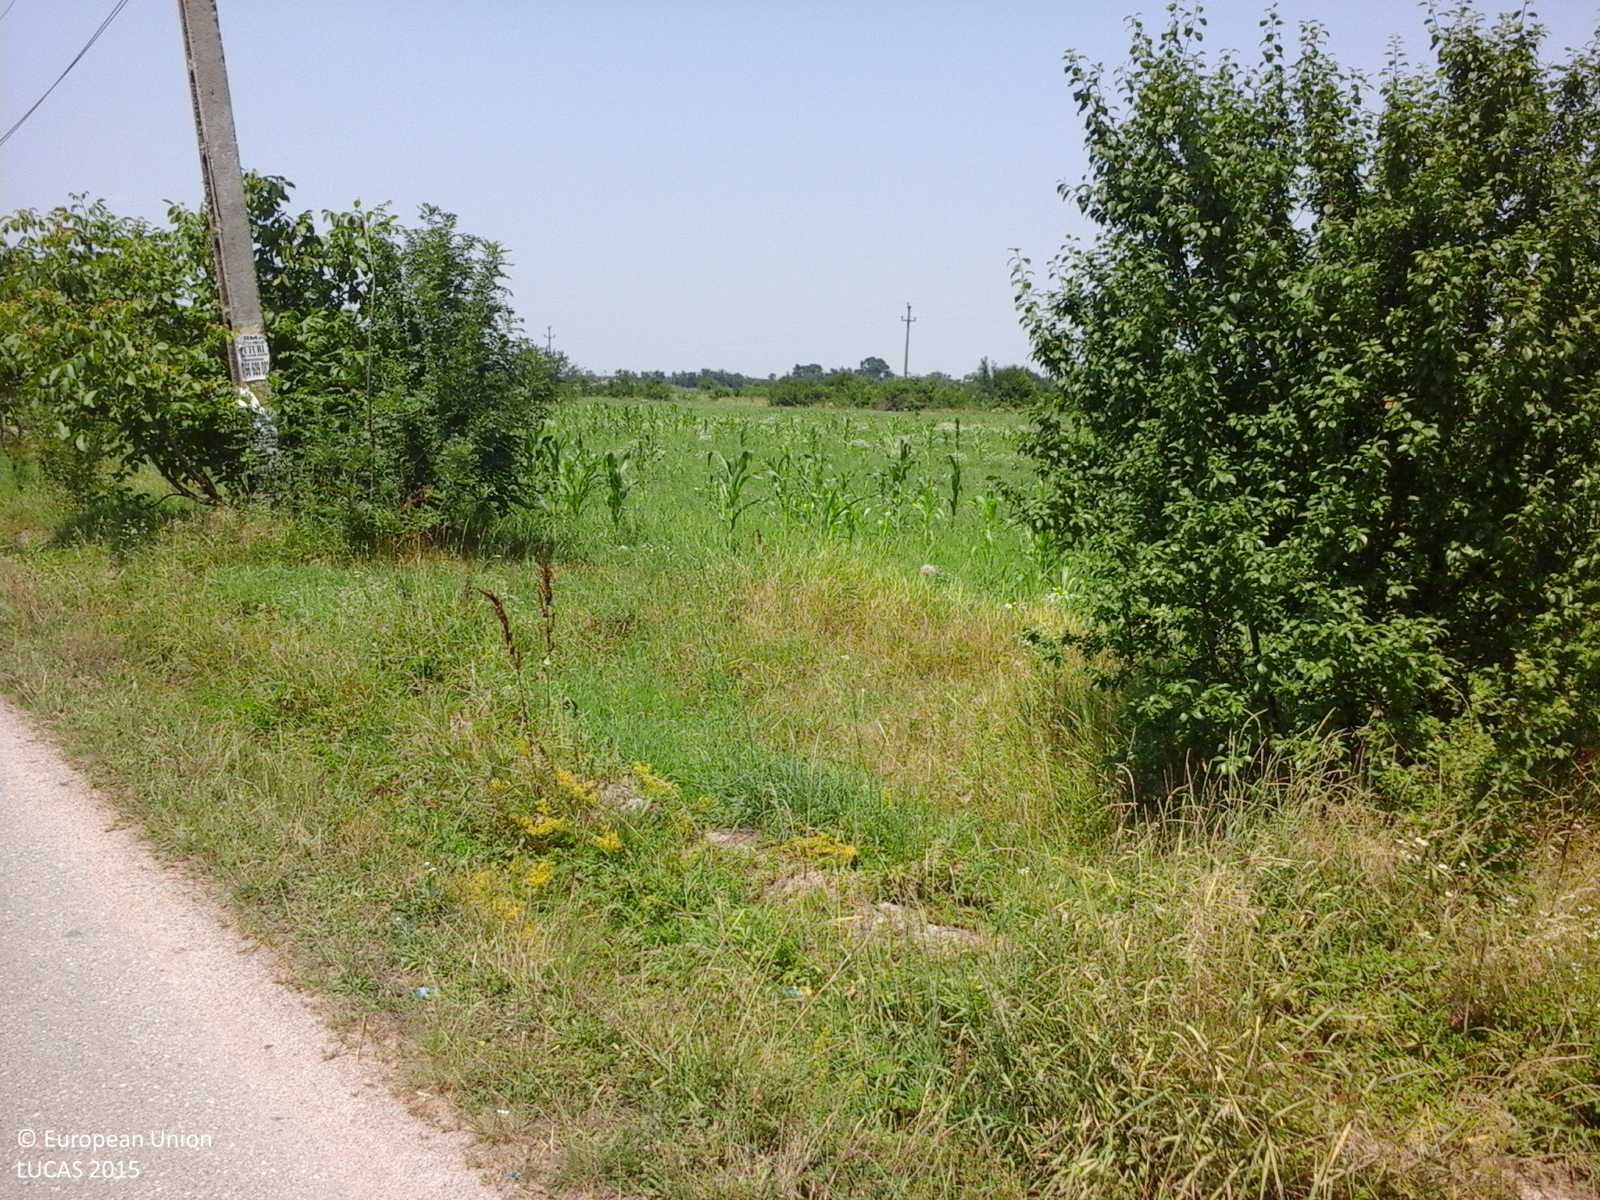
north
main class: Grassland
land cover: Spontaneously vegetated surfaces
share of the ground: > 75 %
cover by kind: herbaceous plants 100 %
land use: Fallow land
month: July
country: RO
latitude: 44.6222
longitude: 25.4039
